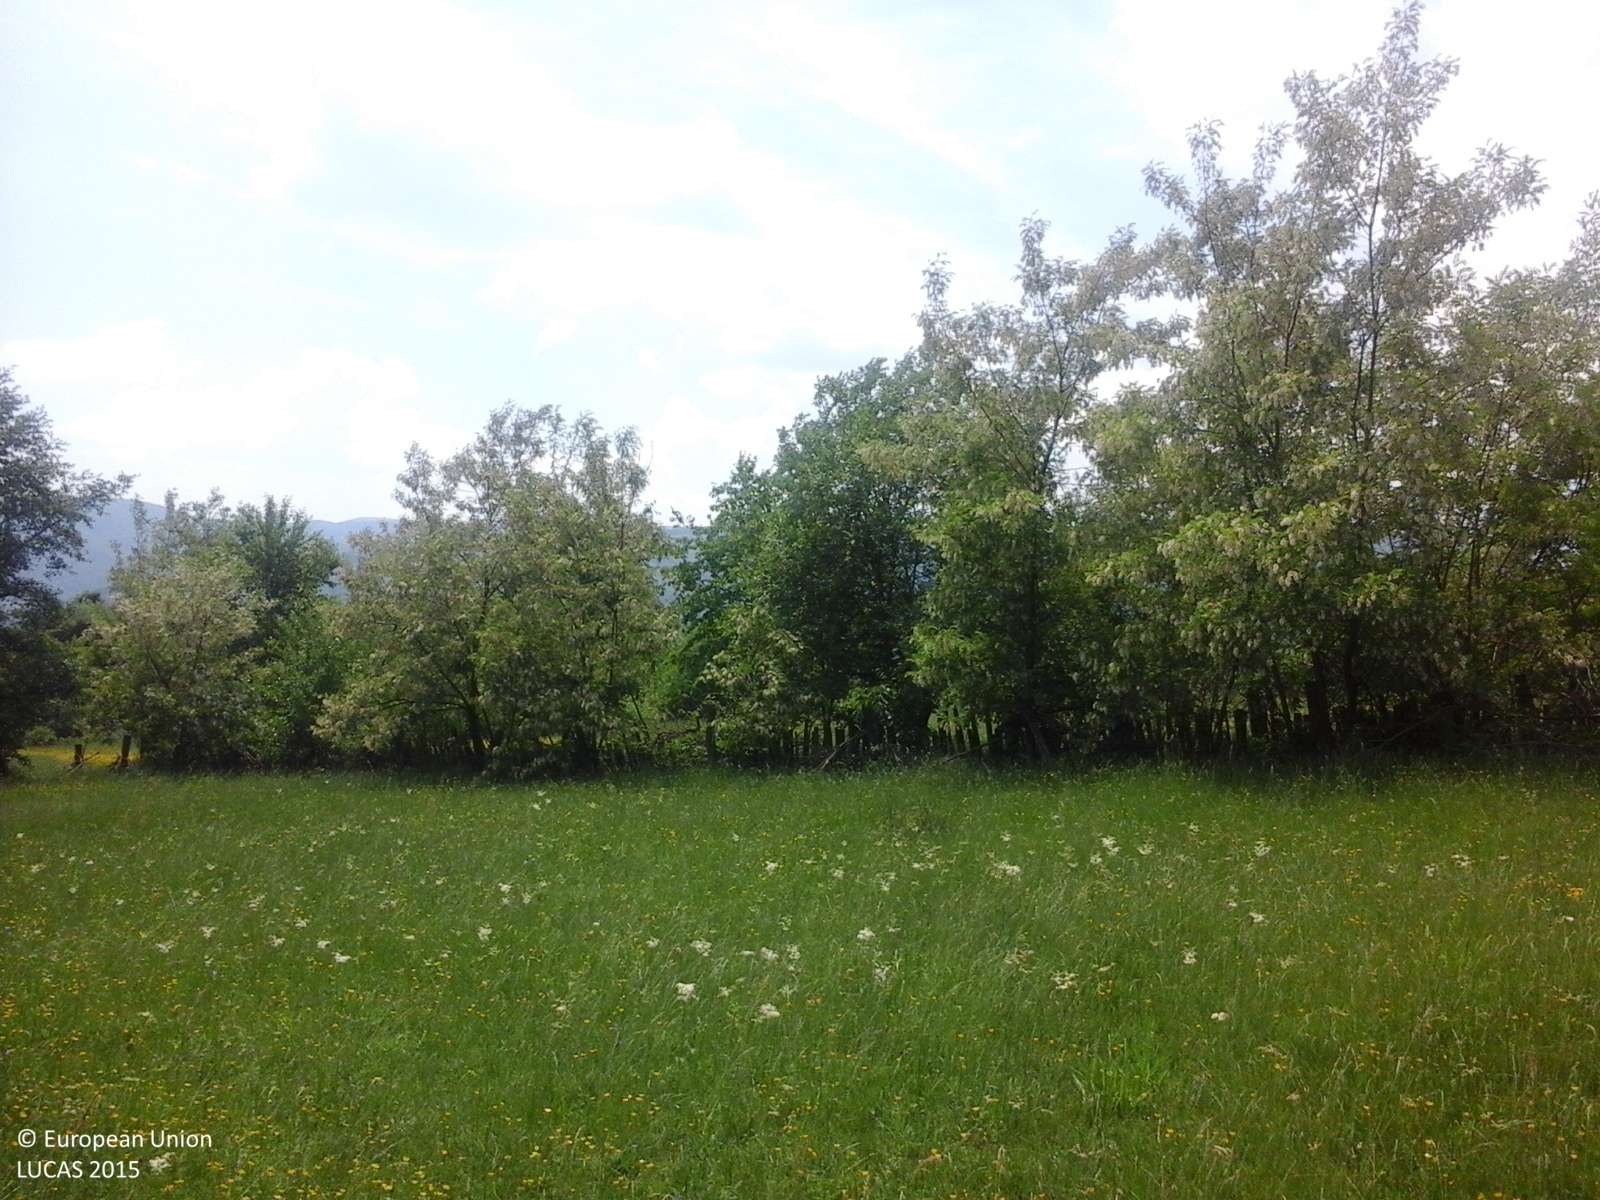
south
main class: Grassland
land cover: Grassland without tree/shrub cover
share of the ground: > 75 %
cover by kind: herbaceous plants 100 %
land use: Agriculture (excluding fallow land and kitchen gardens)
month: June
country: RO
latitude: 46.3575
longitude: 26.4151
